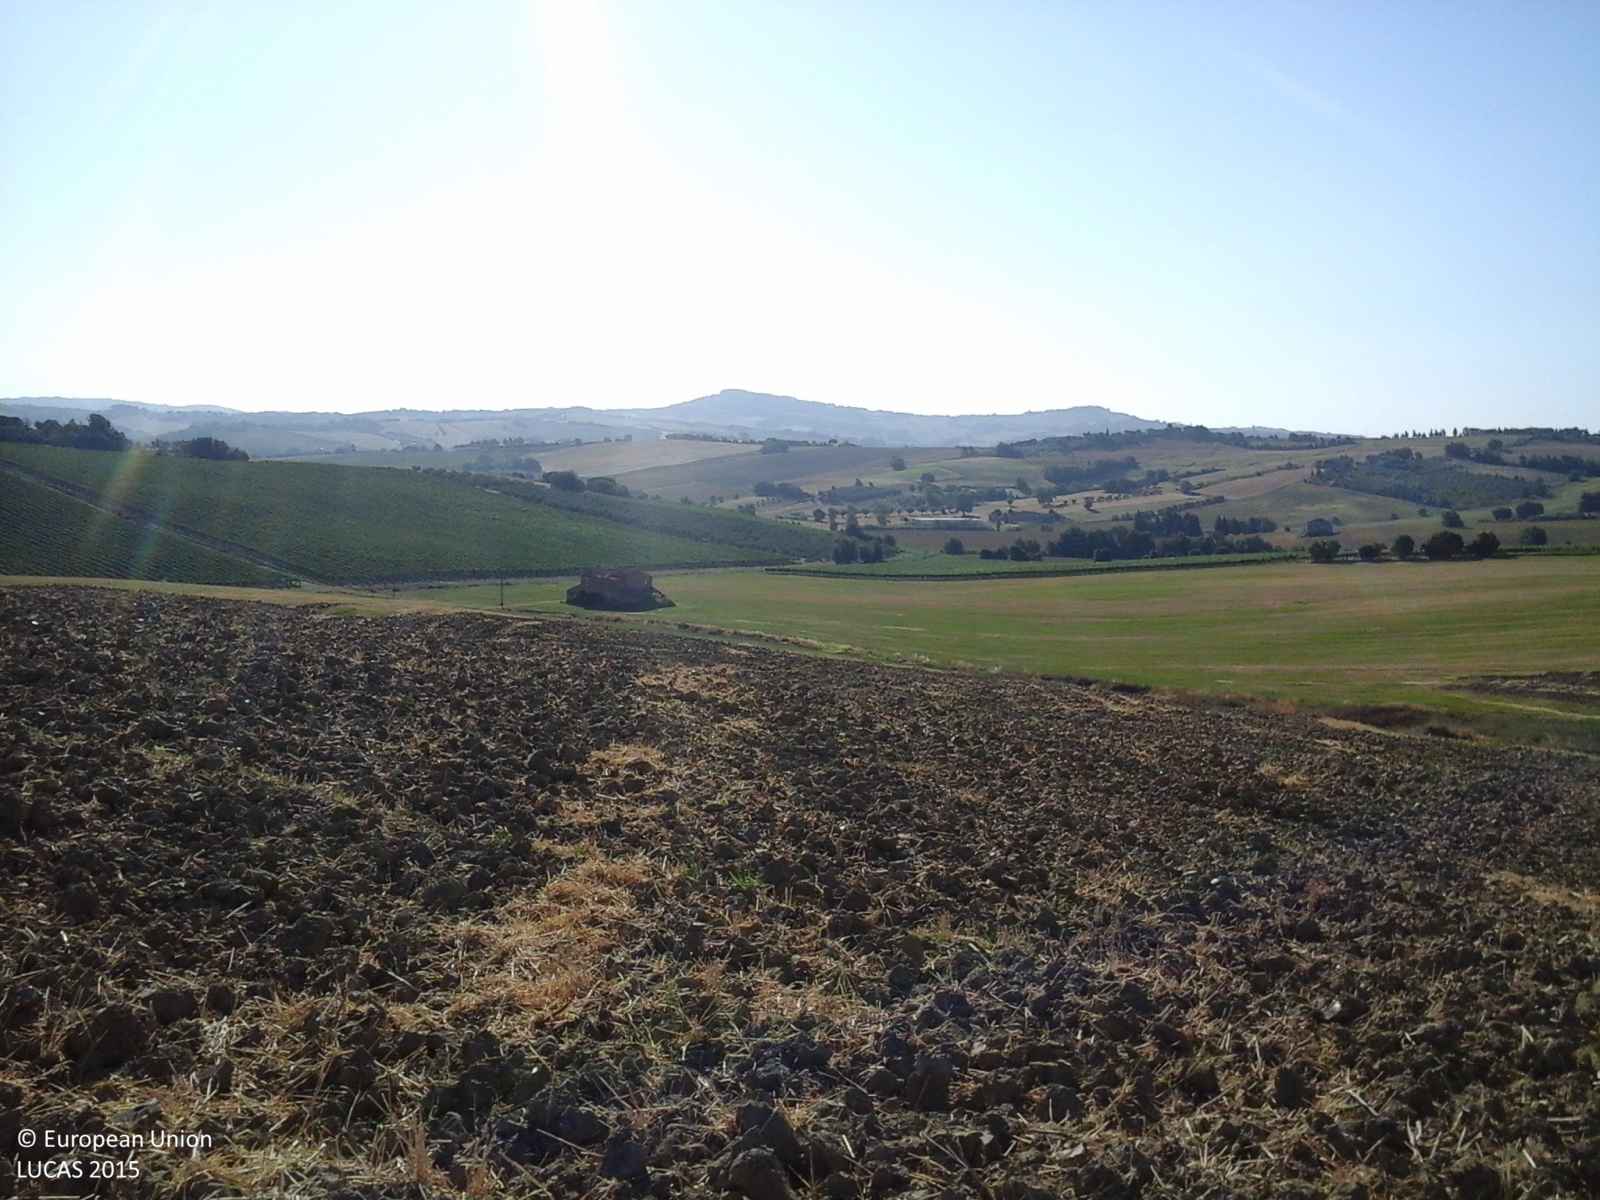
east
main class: Cropland
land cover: Common wheat
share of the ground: < 10 %
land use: Agriculture (excluding fallow land and kitchen gardens)
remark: Harvested field
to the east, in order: Common wheat
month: July
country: IT
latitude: 43.9185
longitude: 12.6962
